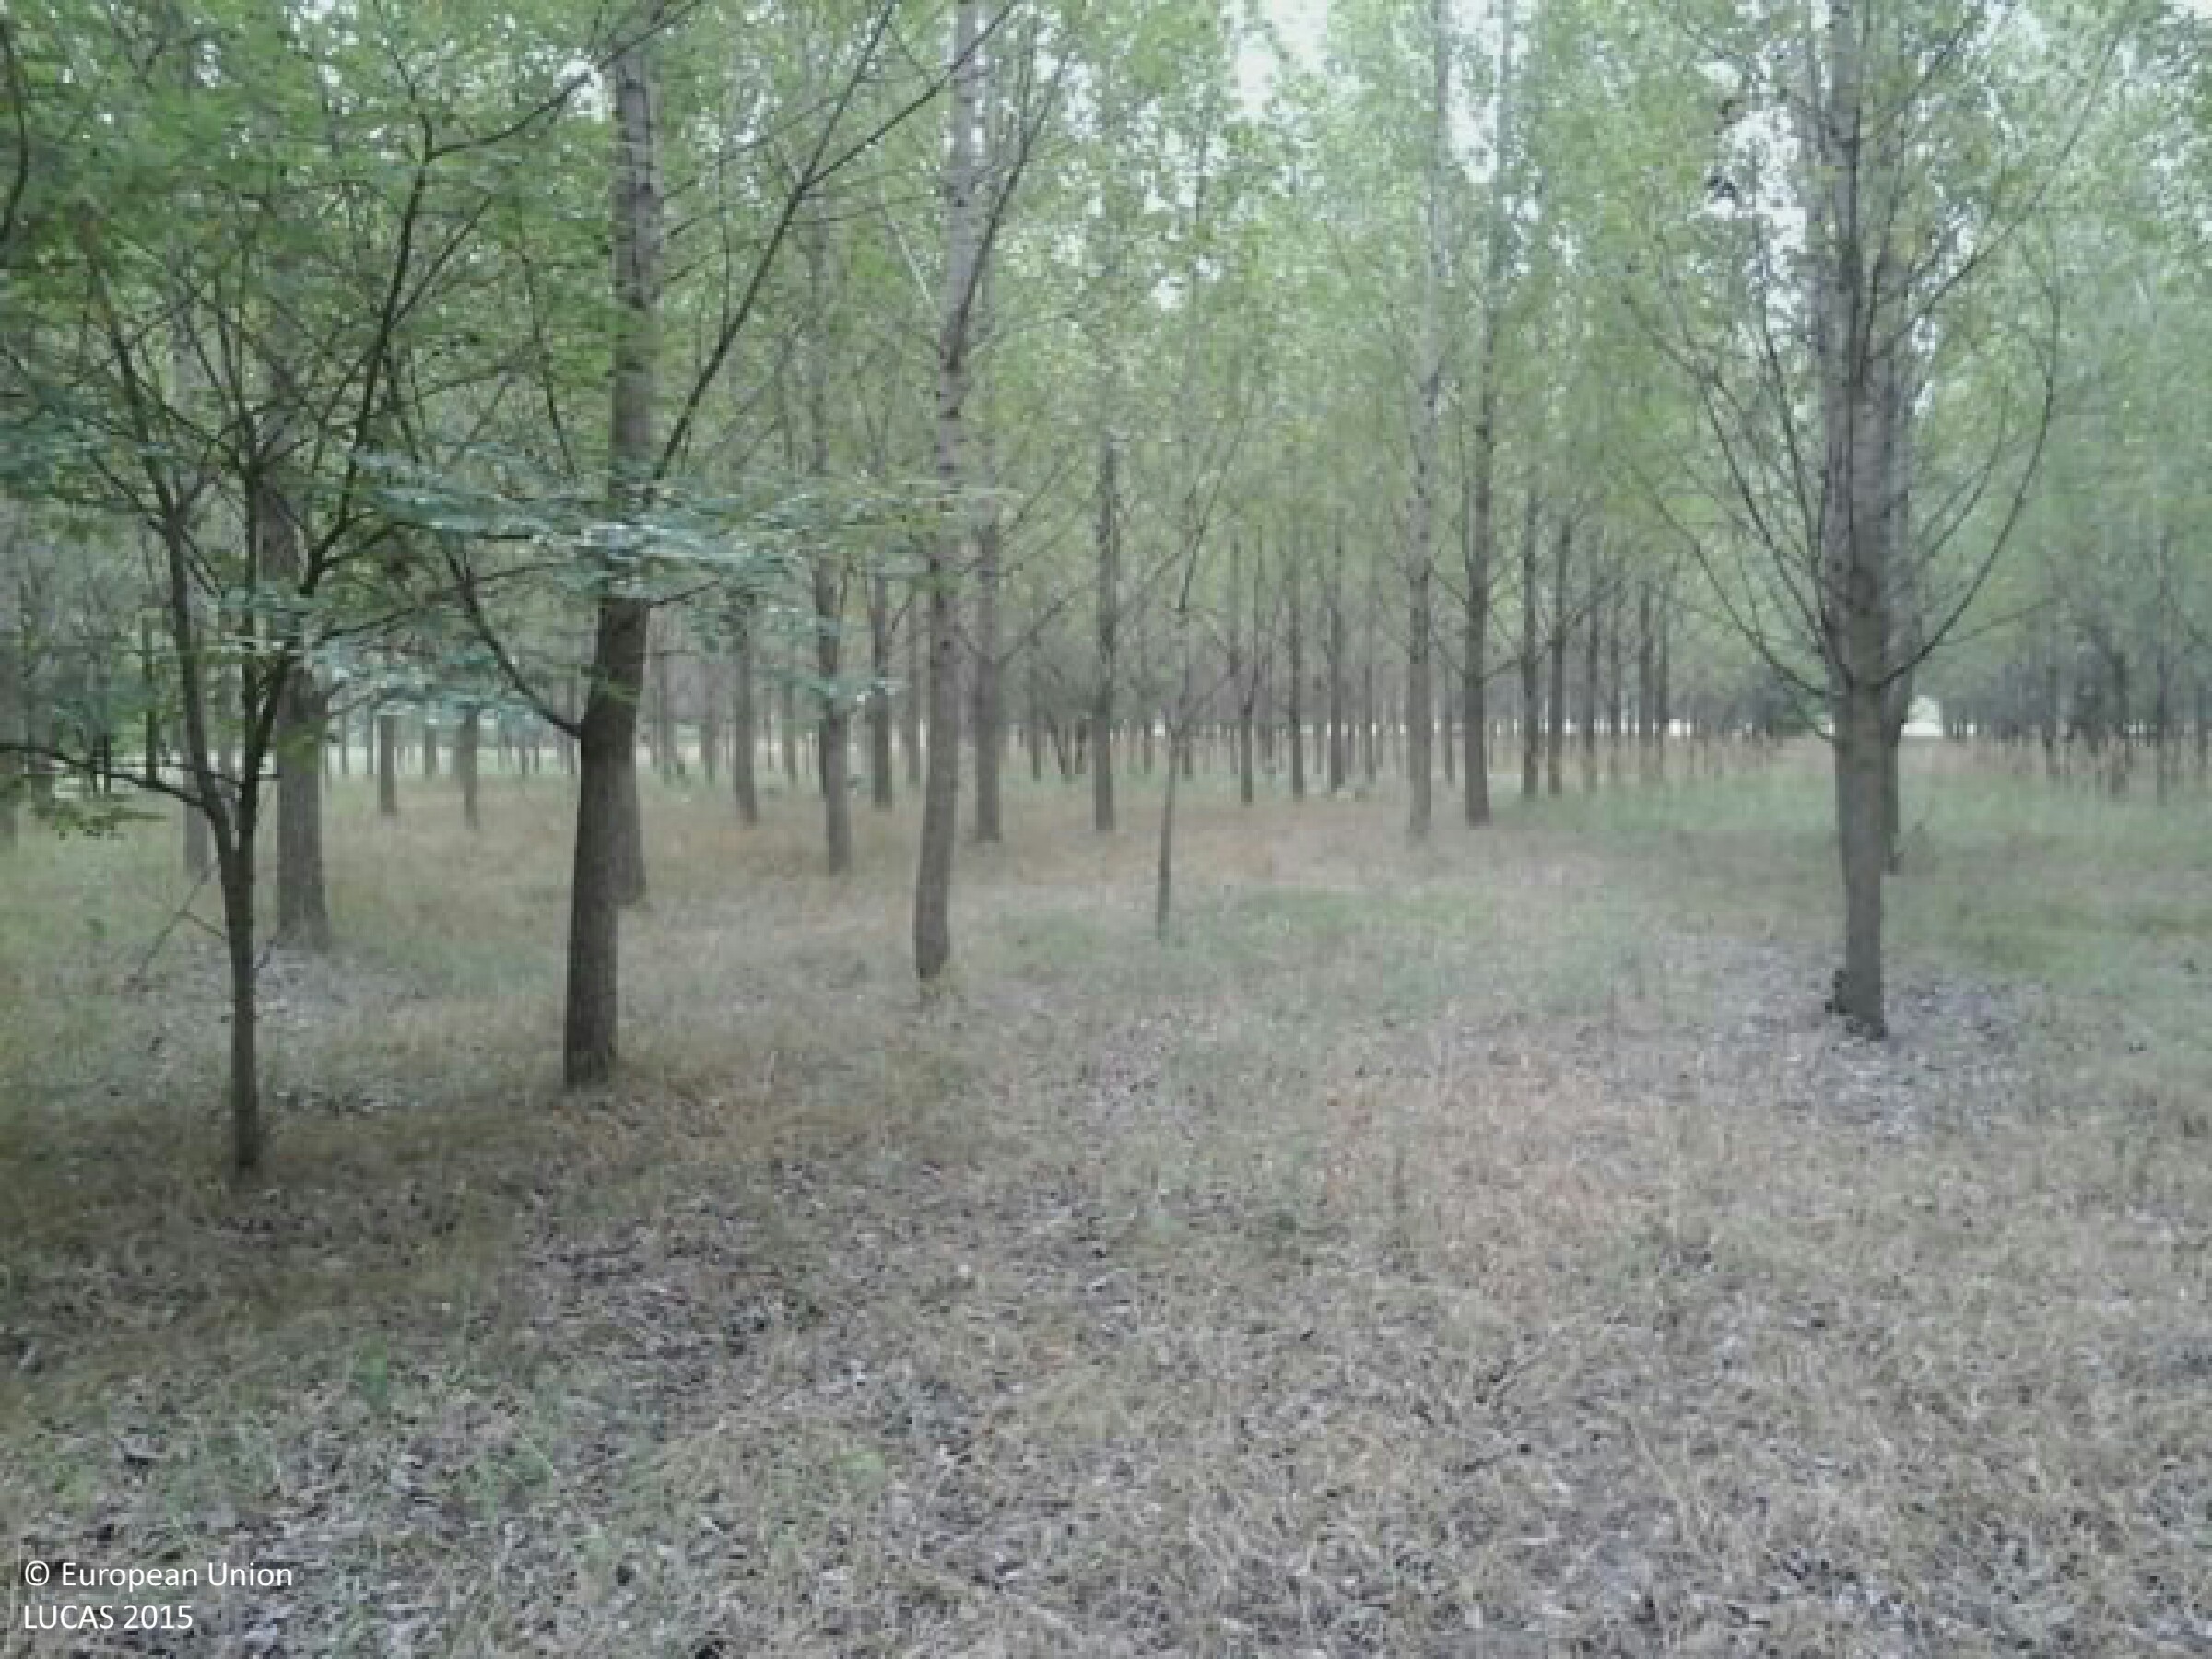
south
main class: Woodland
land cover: Broadleaved woodland
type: mesophytic deciduous forest
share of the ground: > 75 %
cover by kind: broadleaved forest trees 80 %, herbaceous plants 20 %
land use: Forestry
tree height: > 5 m
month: July
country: HU
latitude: 47.1257
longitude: 19.6840
